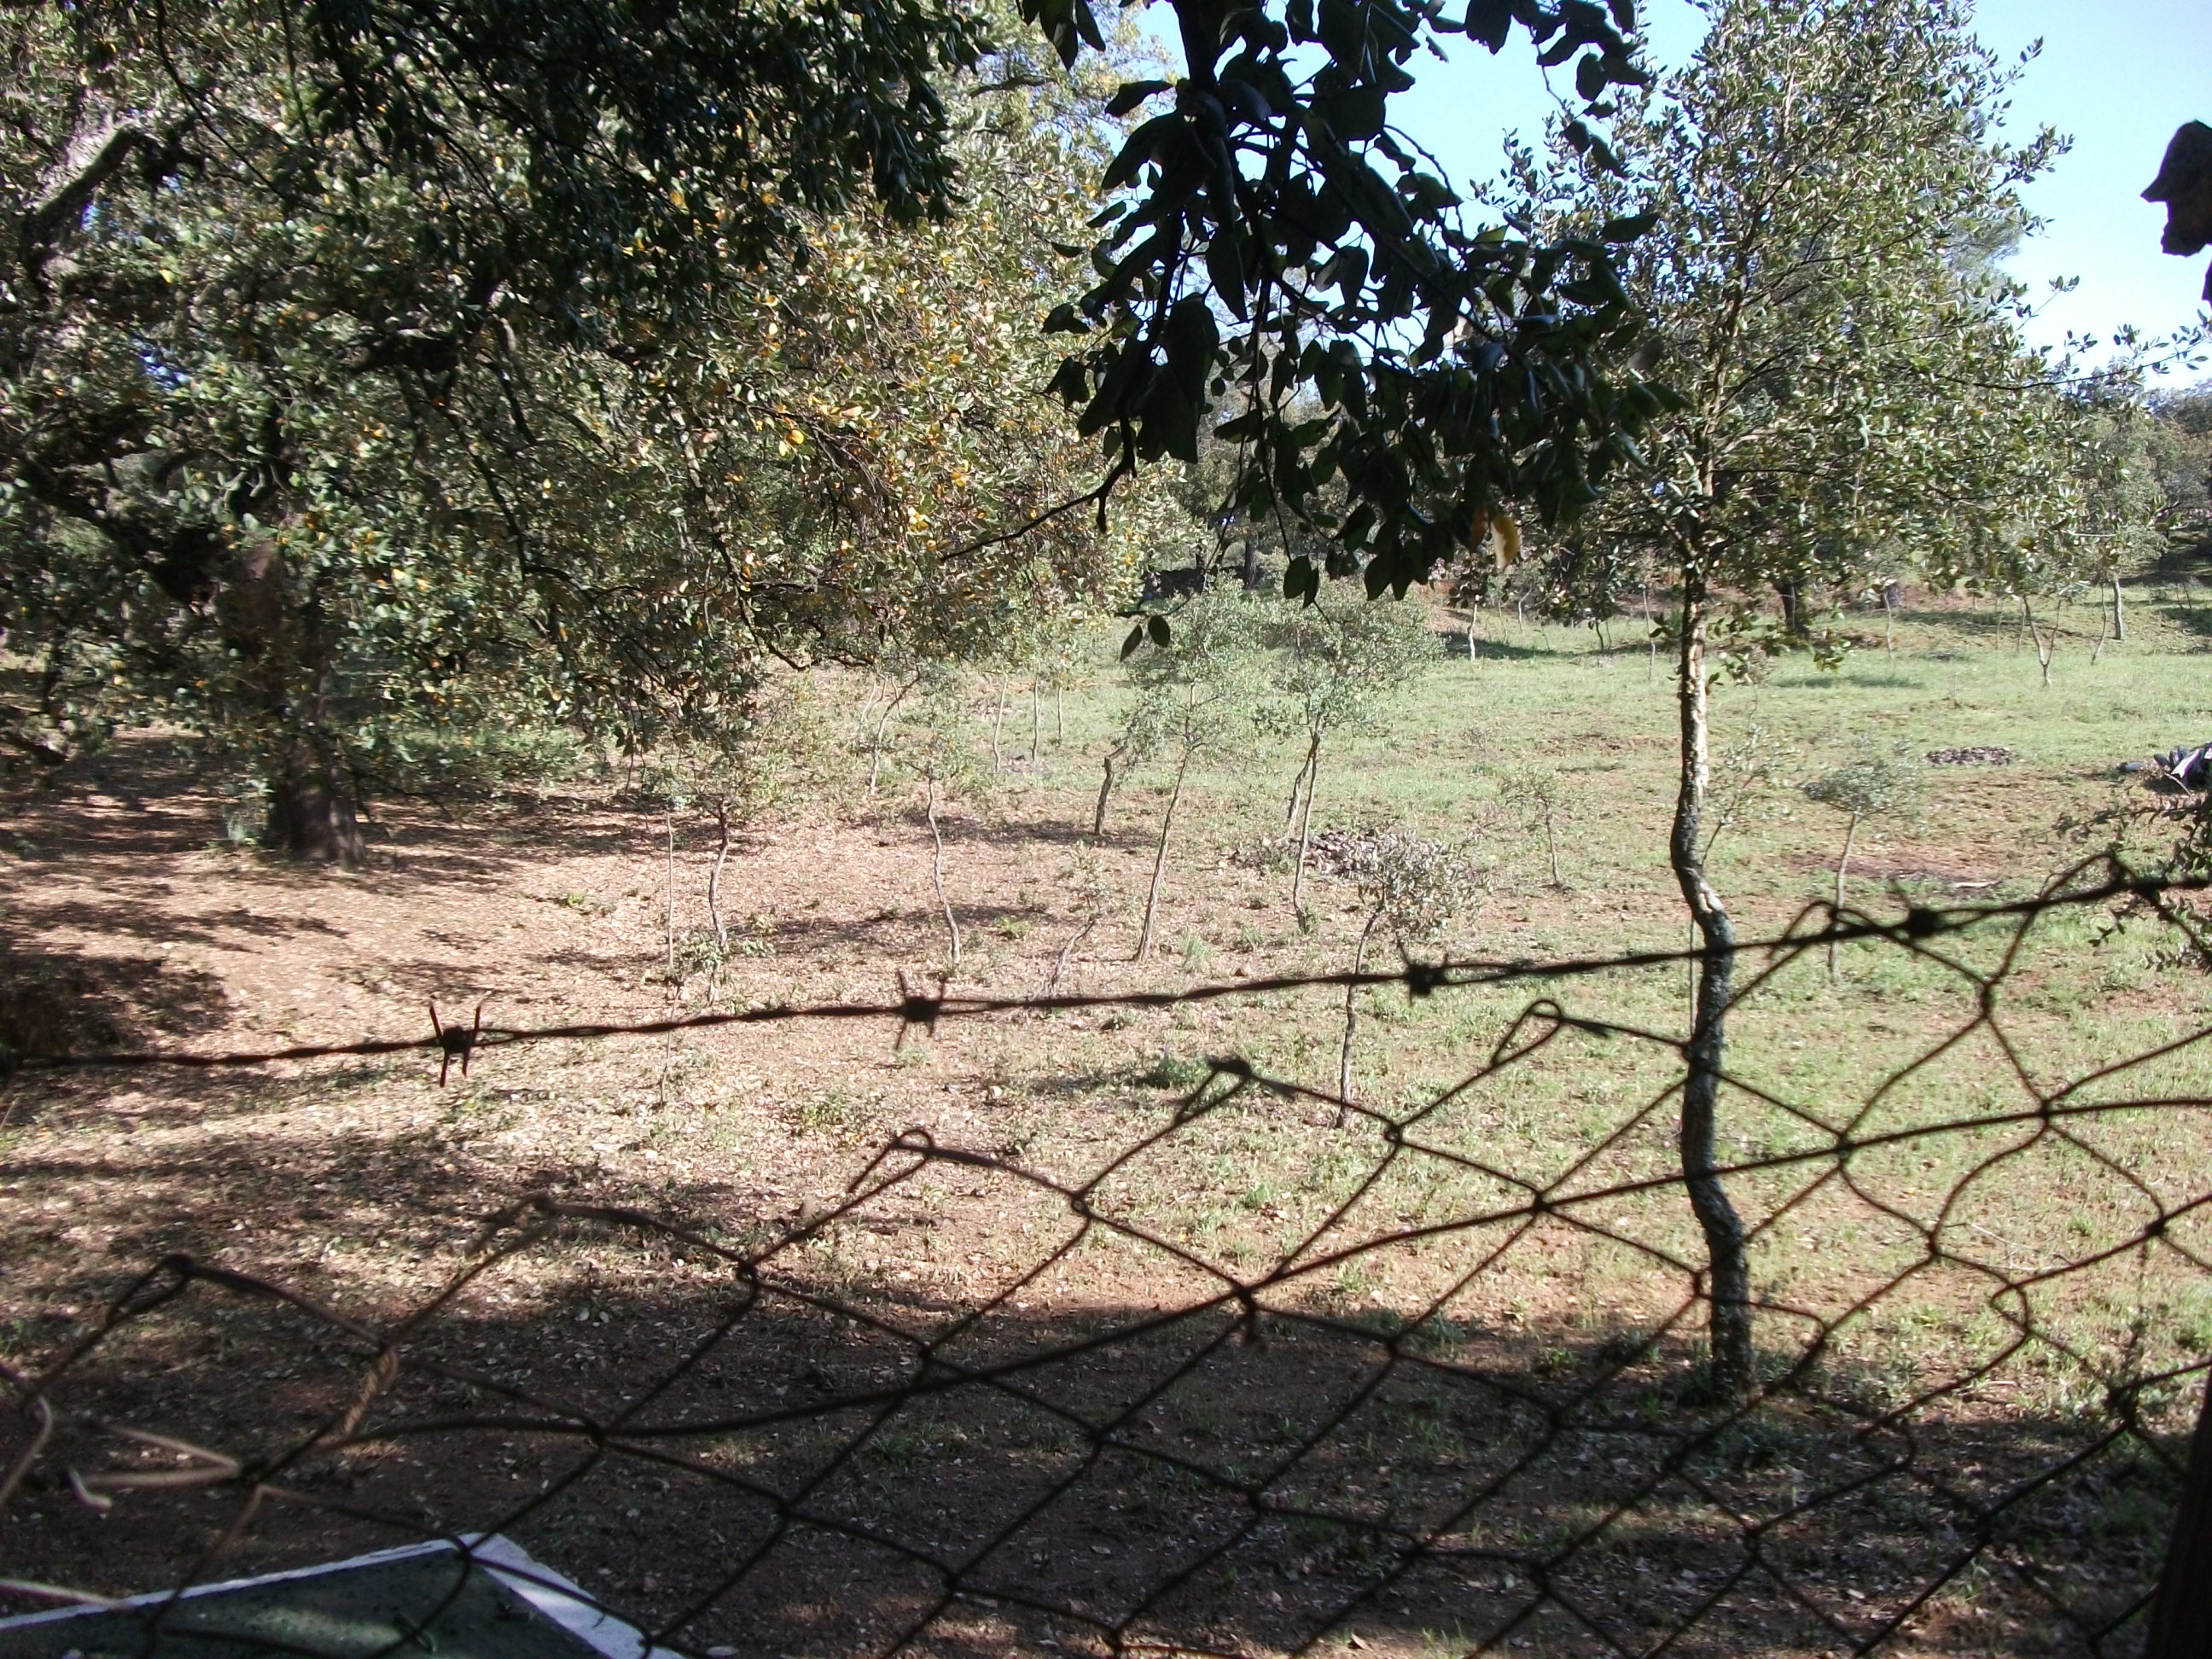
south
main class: Woodland
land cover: Broadleaved woodland
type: broadleaved evergreen forest
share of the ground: 50 - 75 %
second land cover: Grassland without tree/shrub cover
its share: > 75 %
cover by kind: broadleaved forest trees 60 %, herbaceous plants 40 %
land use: Forestry
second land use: Agriculture (excluding fallow land and kitchen gardens)
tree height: > 5 m
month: April
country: ES
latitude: 37.8698
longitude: -6.6763
